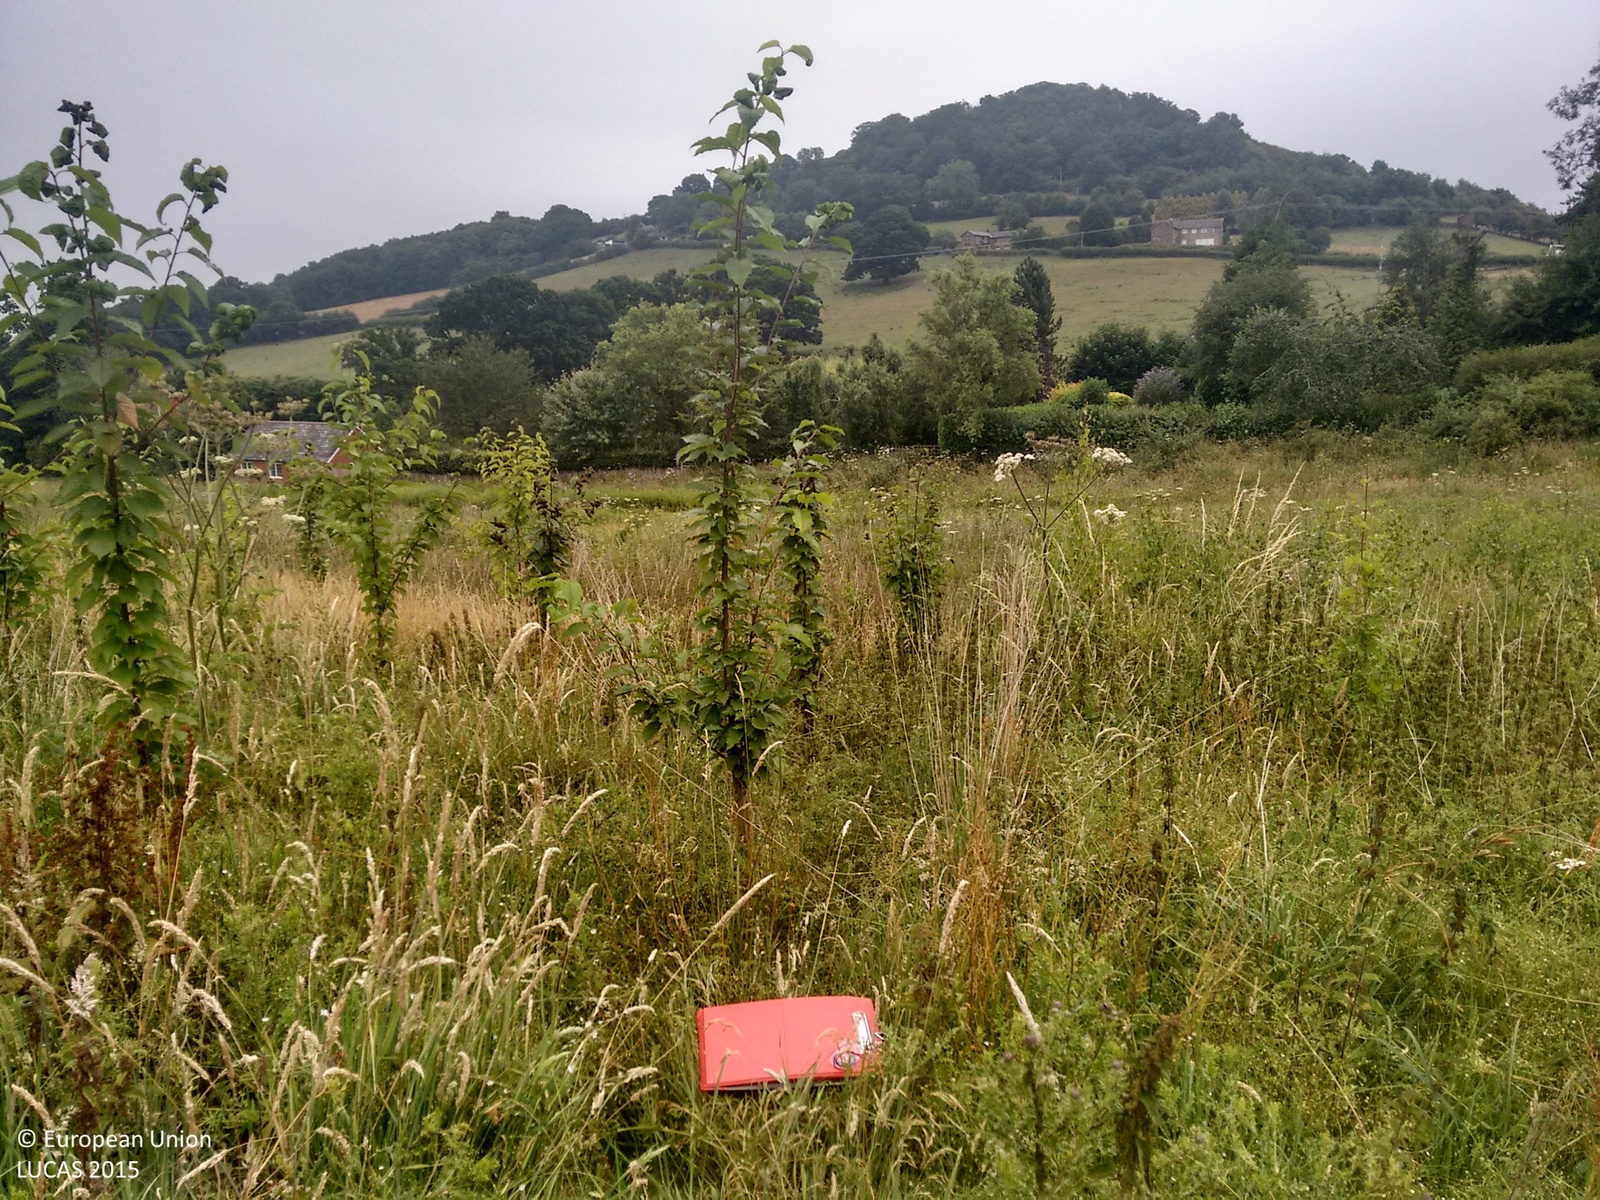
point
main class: Grassland
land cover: Grassland with sparse tree/shrub cover
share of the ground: > 75 %
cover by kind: herbaceous plants 90 %, broadleaved forest trees 5 %, shrubs 5 %
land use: Semi-natural and natural areas not in use
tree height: < 5 m
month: July
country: GB
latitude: 52.0192
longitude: -2.7039
